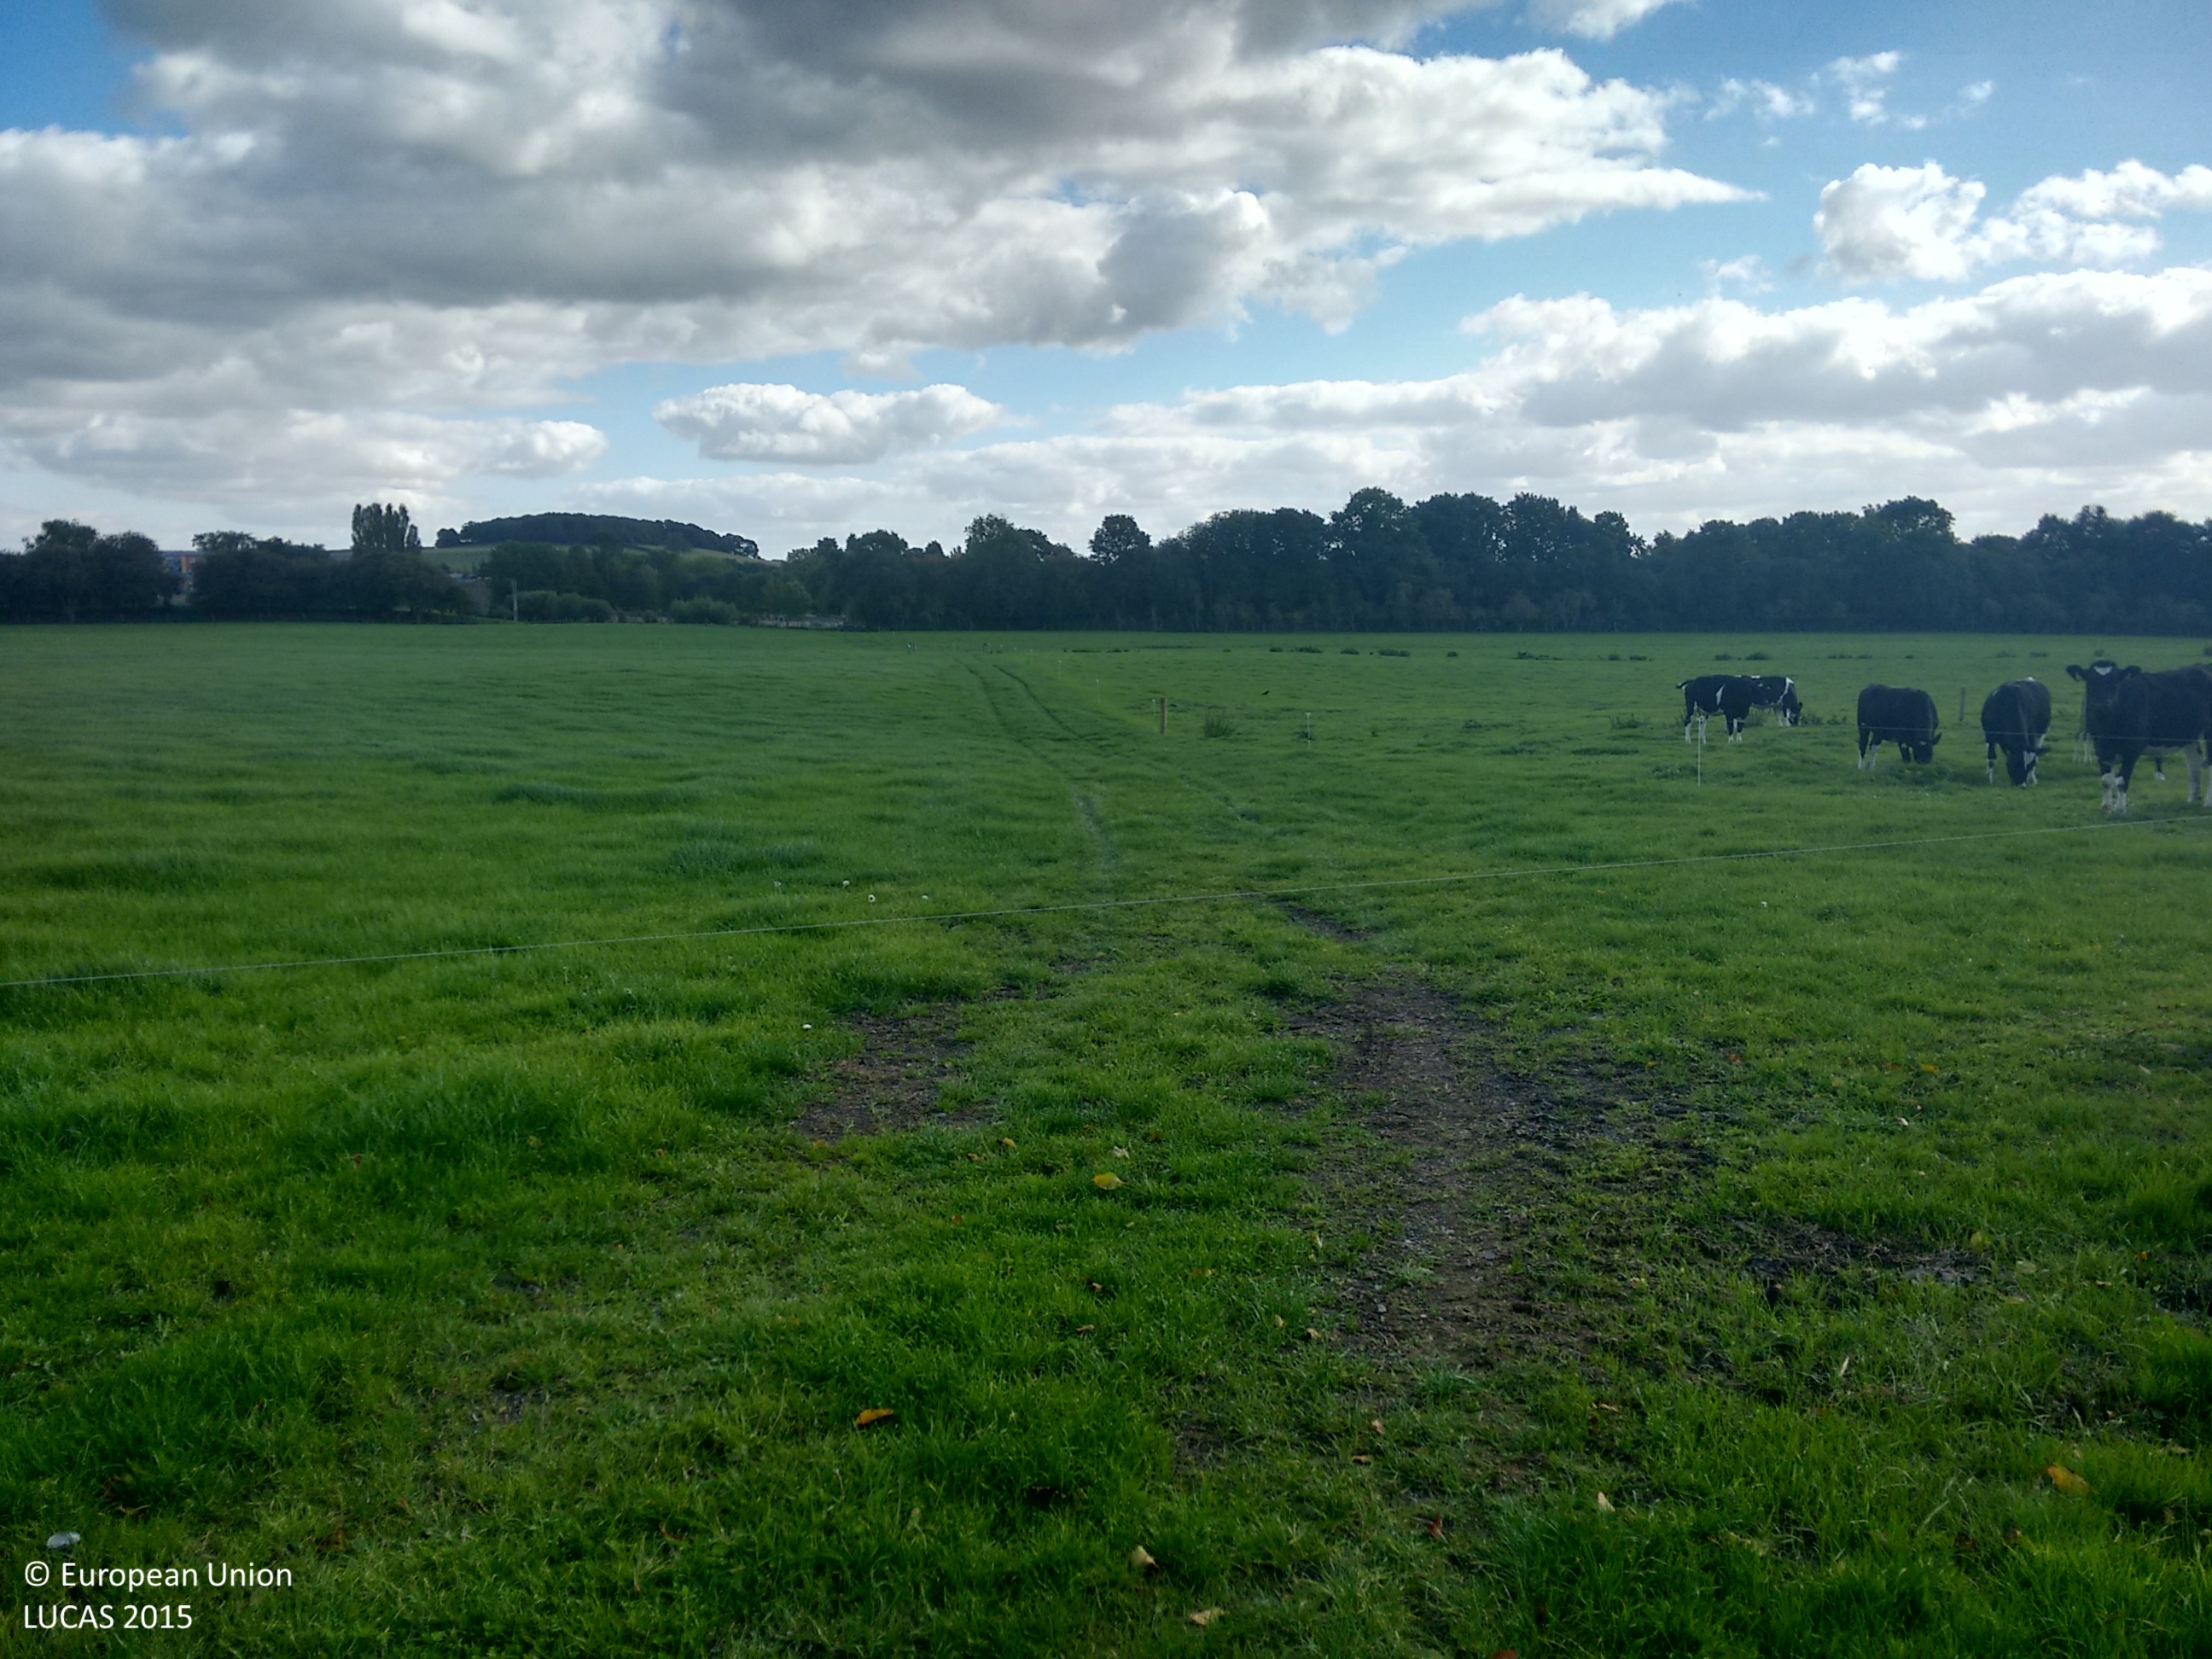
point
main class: Grassland
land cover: Grassland without tree/shrub cover
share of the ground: > 75 %
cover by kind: herbaceous plants 100 %
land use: Agriculture (excluding fallow land and kitchen gardens)
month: September
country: GB
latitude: 52.8292
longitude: -2.0965
